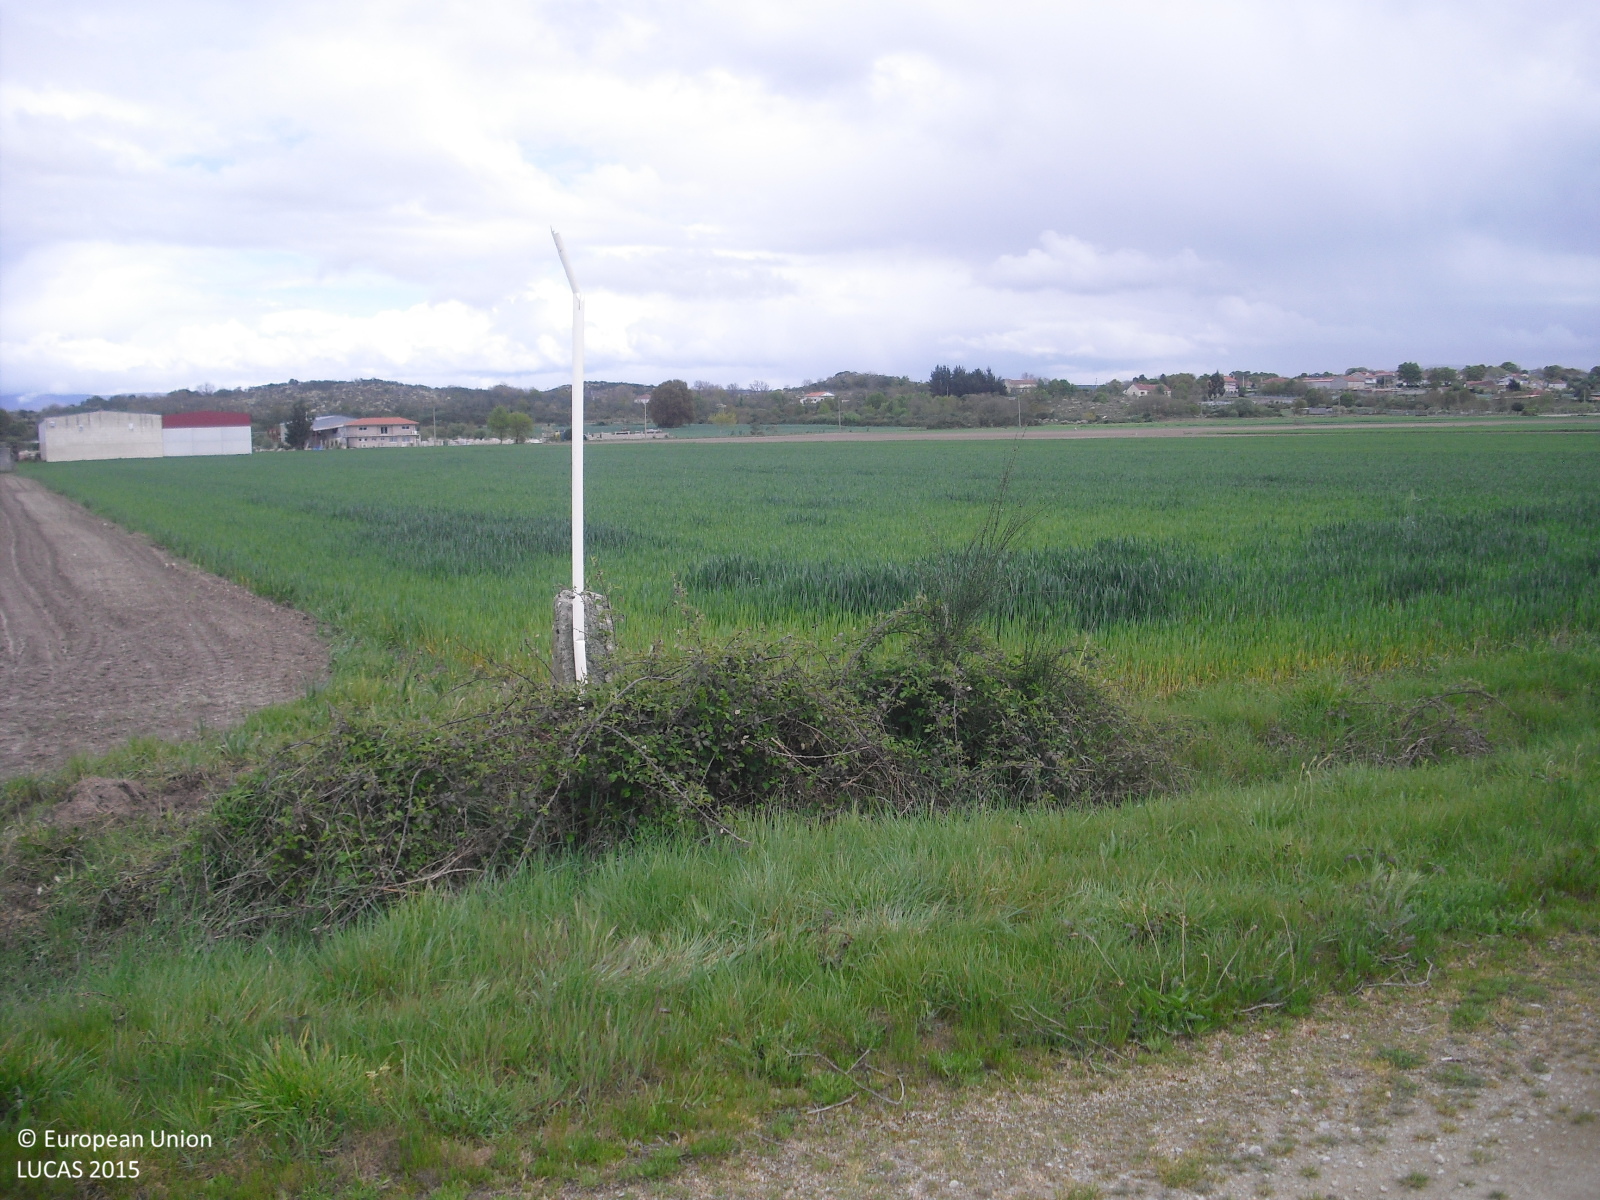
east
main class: Artificial land
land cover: Non built-up linear features
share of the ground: > 75 %
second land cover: Spontaneously vegetated surfaces
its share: 25 - 50 %
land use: Road transport
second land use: Agriculture (excluding fallow land and kitchen gardens)
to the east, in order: Grass margins; Tracks; Grass margins; Ditches and canals; Shruby margins; Common wheat; Potatoes
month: April
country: ES
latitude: 42.0449
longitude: -7.6701
